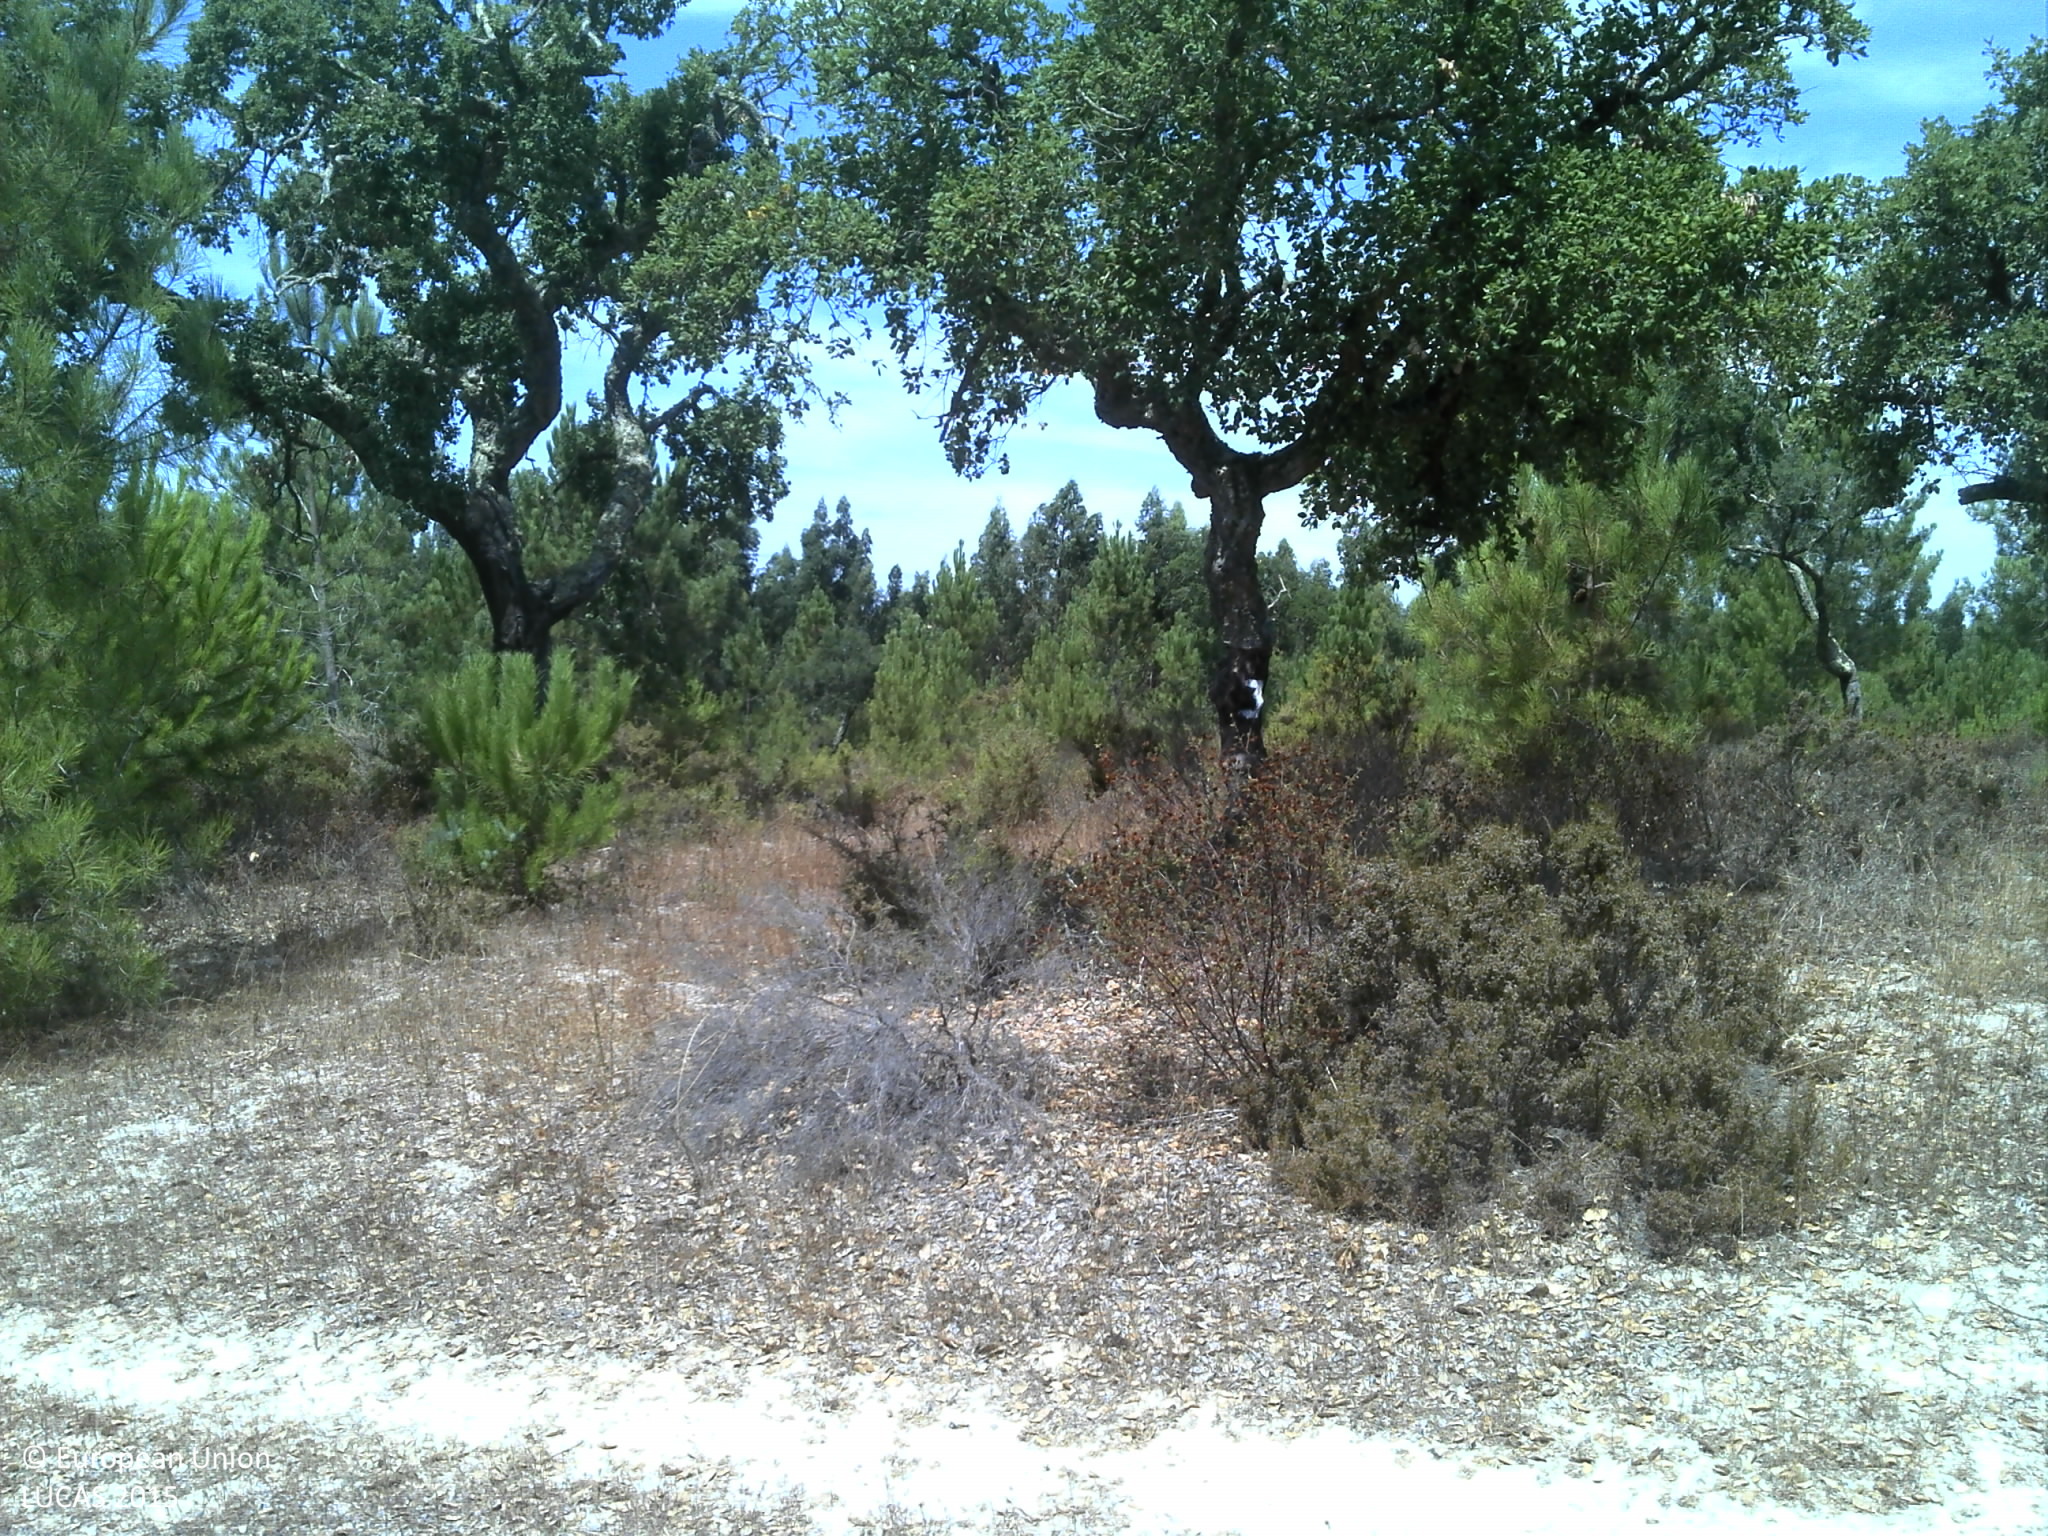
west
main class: Woodland
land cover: Broadleaved woodland
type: broadleaved evergreen forest
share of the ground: 25 - 50 %
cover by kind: broadleaved forest trees 45 %, herbaceous plants 40 %, unconsolidated bare surface 15 %
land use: Forestry
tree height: > 5 m
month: August
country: PT
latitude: 38.8324
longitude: -8.5499
